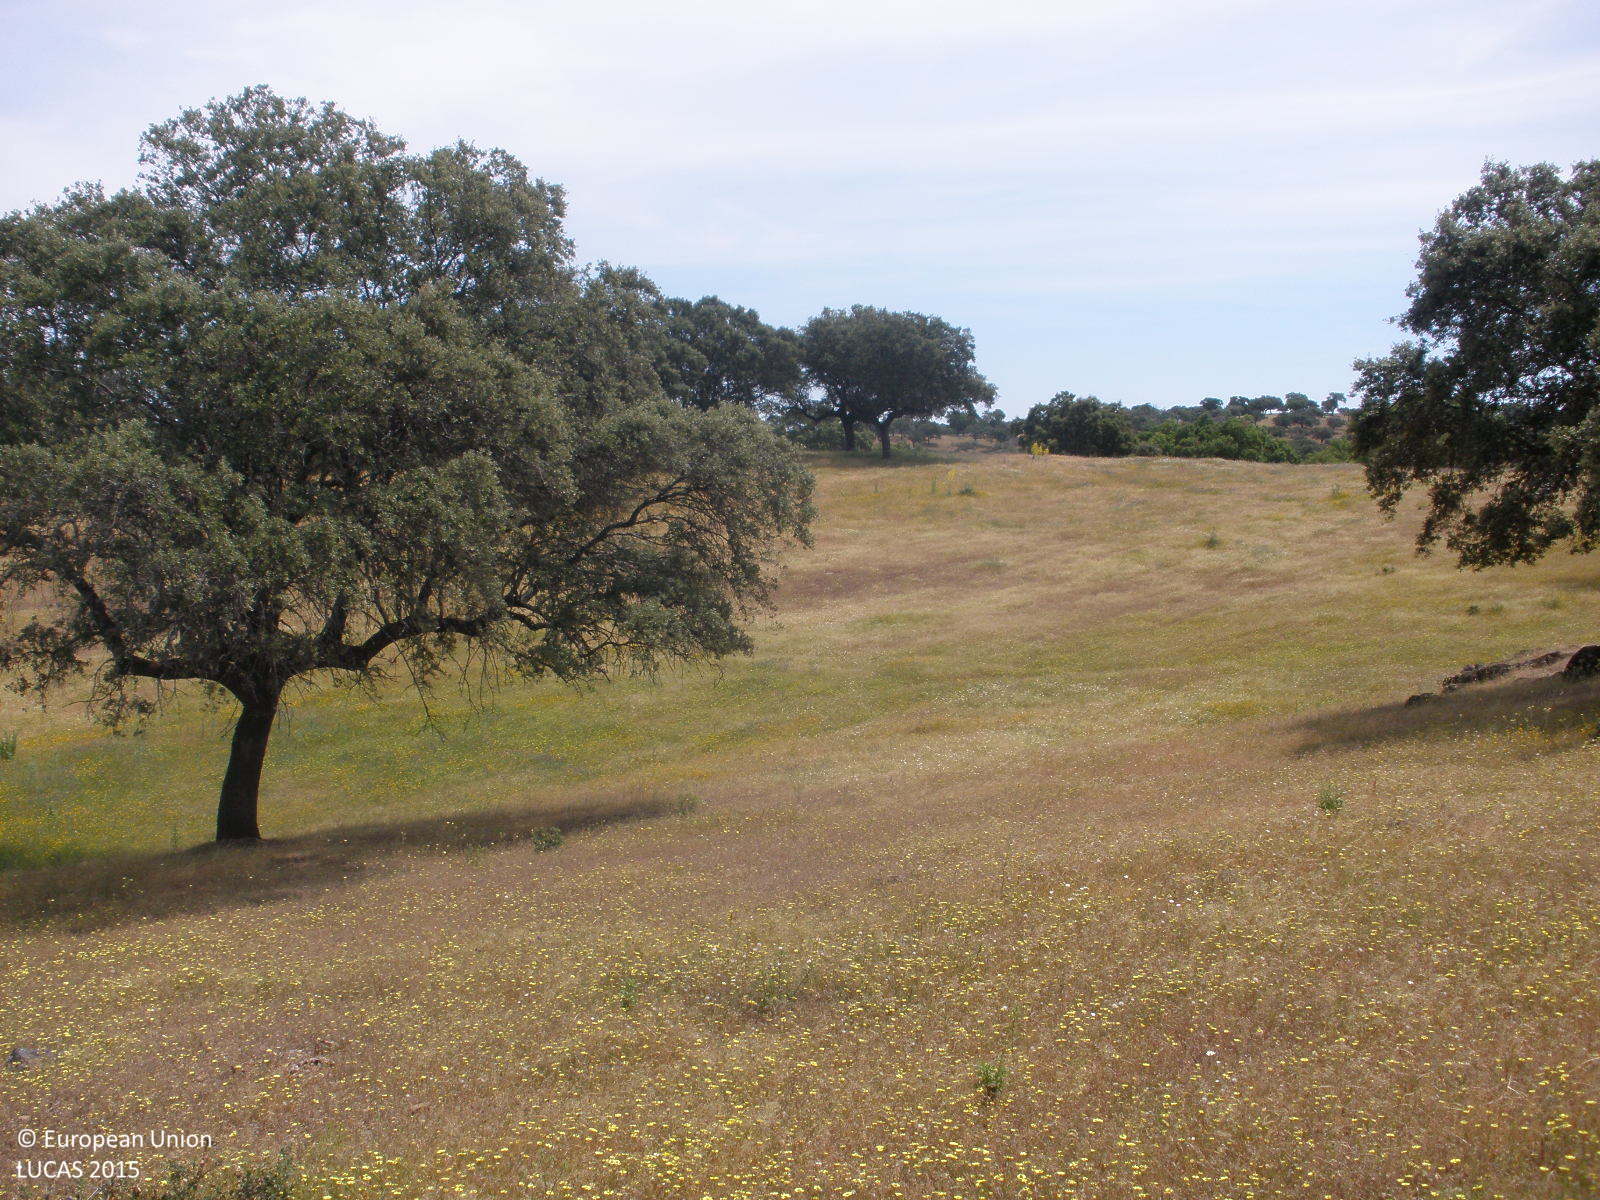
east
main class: Grassland
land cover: Grassland without tree/shrub cover
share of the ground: > 75 %
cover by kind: herbaceous plants 100 %
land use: Agriculture (excluding fallow land and kitchen gardens)
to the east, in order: Grassland without tree/shrub cover; Broadleaved woodland; Grassland without tree/shrub cover; Broadleaved woodland; Grassland without tree/shrub cover
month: May
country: ES
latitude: 40.1186
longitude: -6.5686
